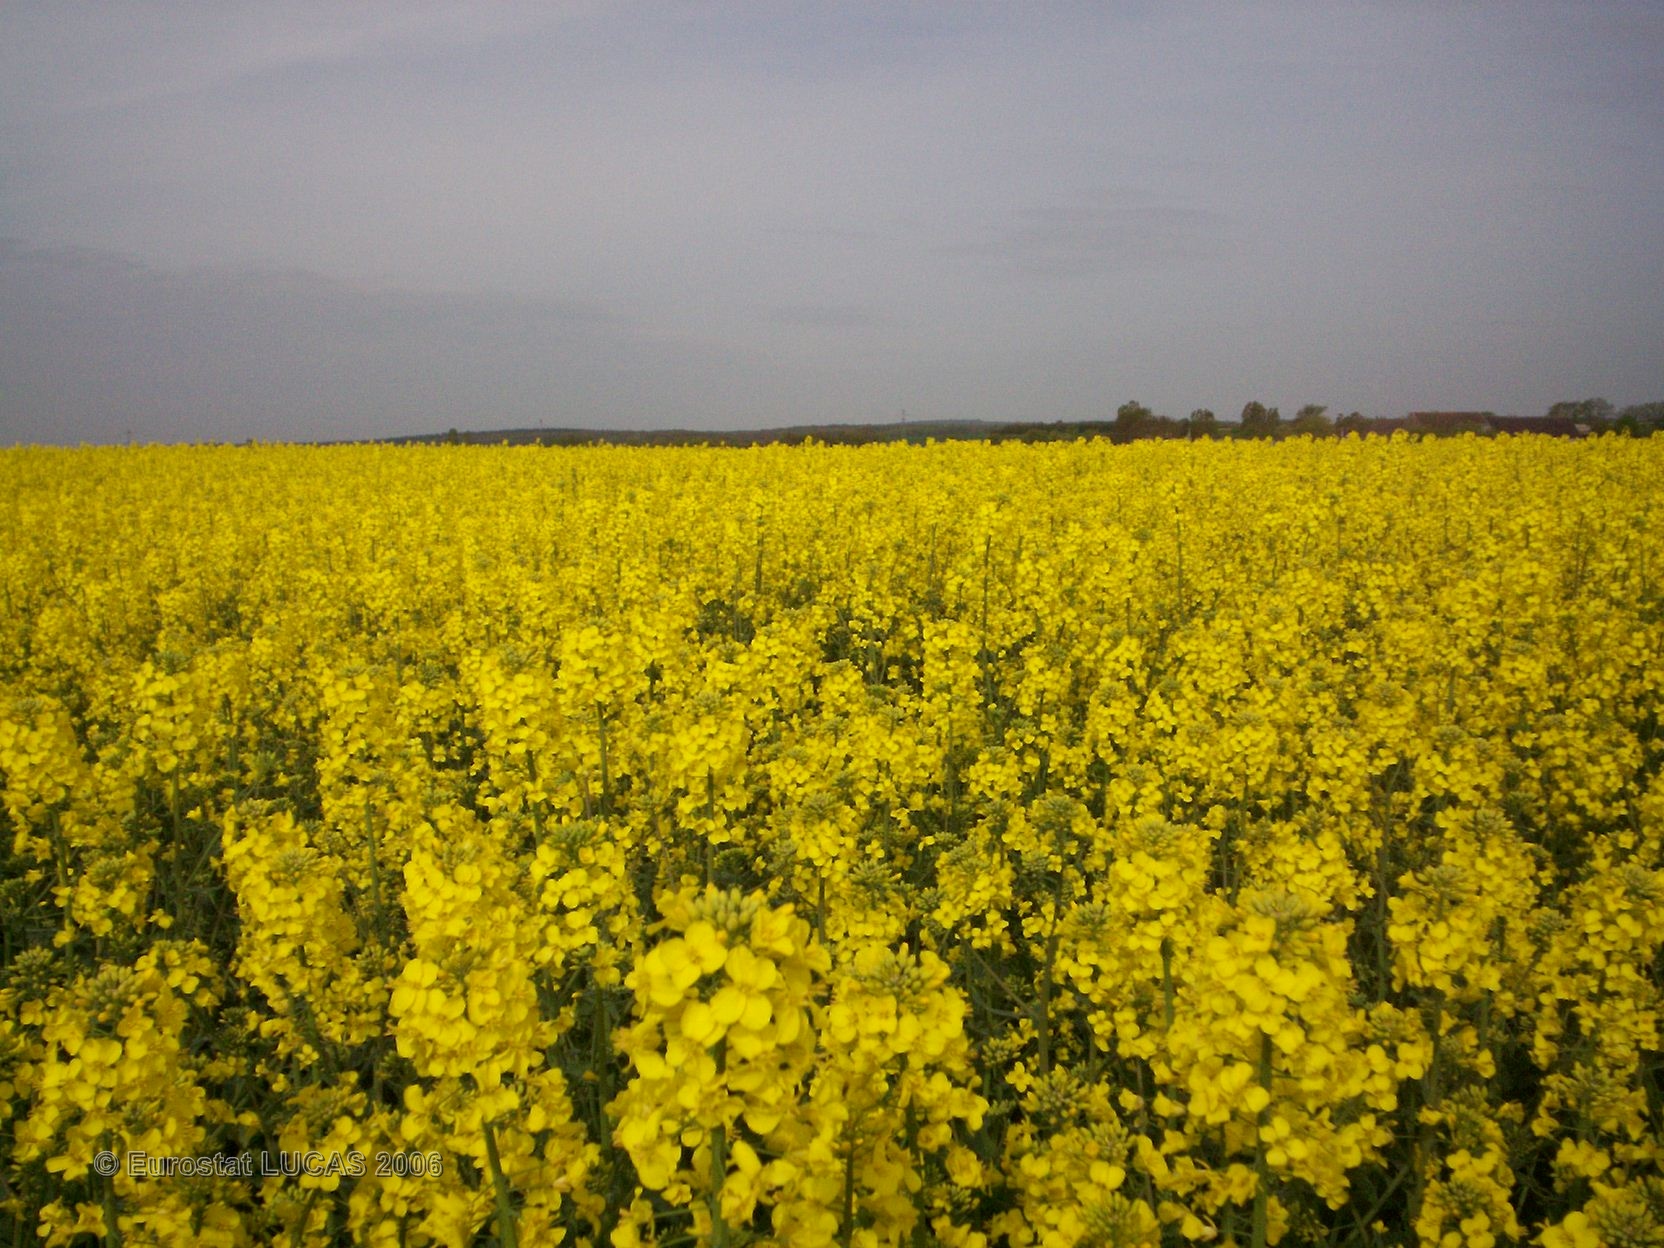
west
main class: Cropland
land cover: Rape and turnip rape
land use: Agriculture (excluding fallow land and kitchen gardens)
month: May
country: FR
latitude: 47.2998
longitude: 3.0518
